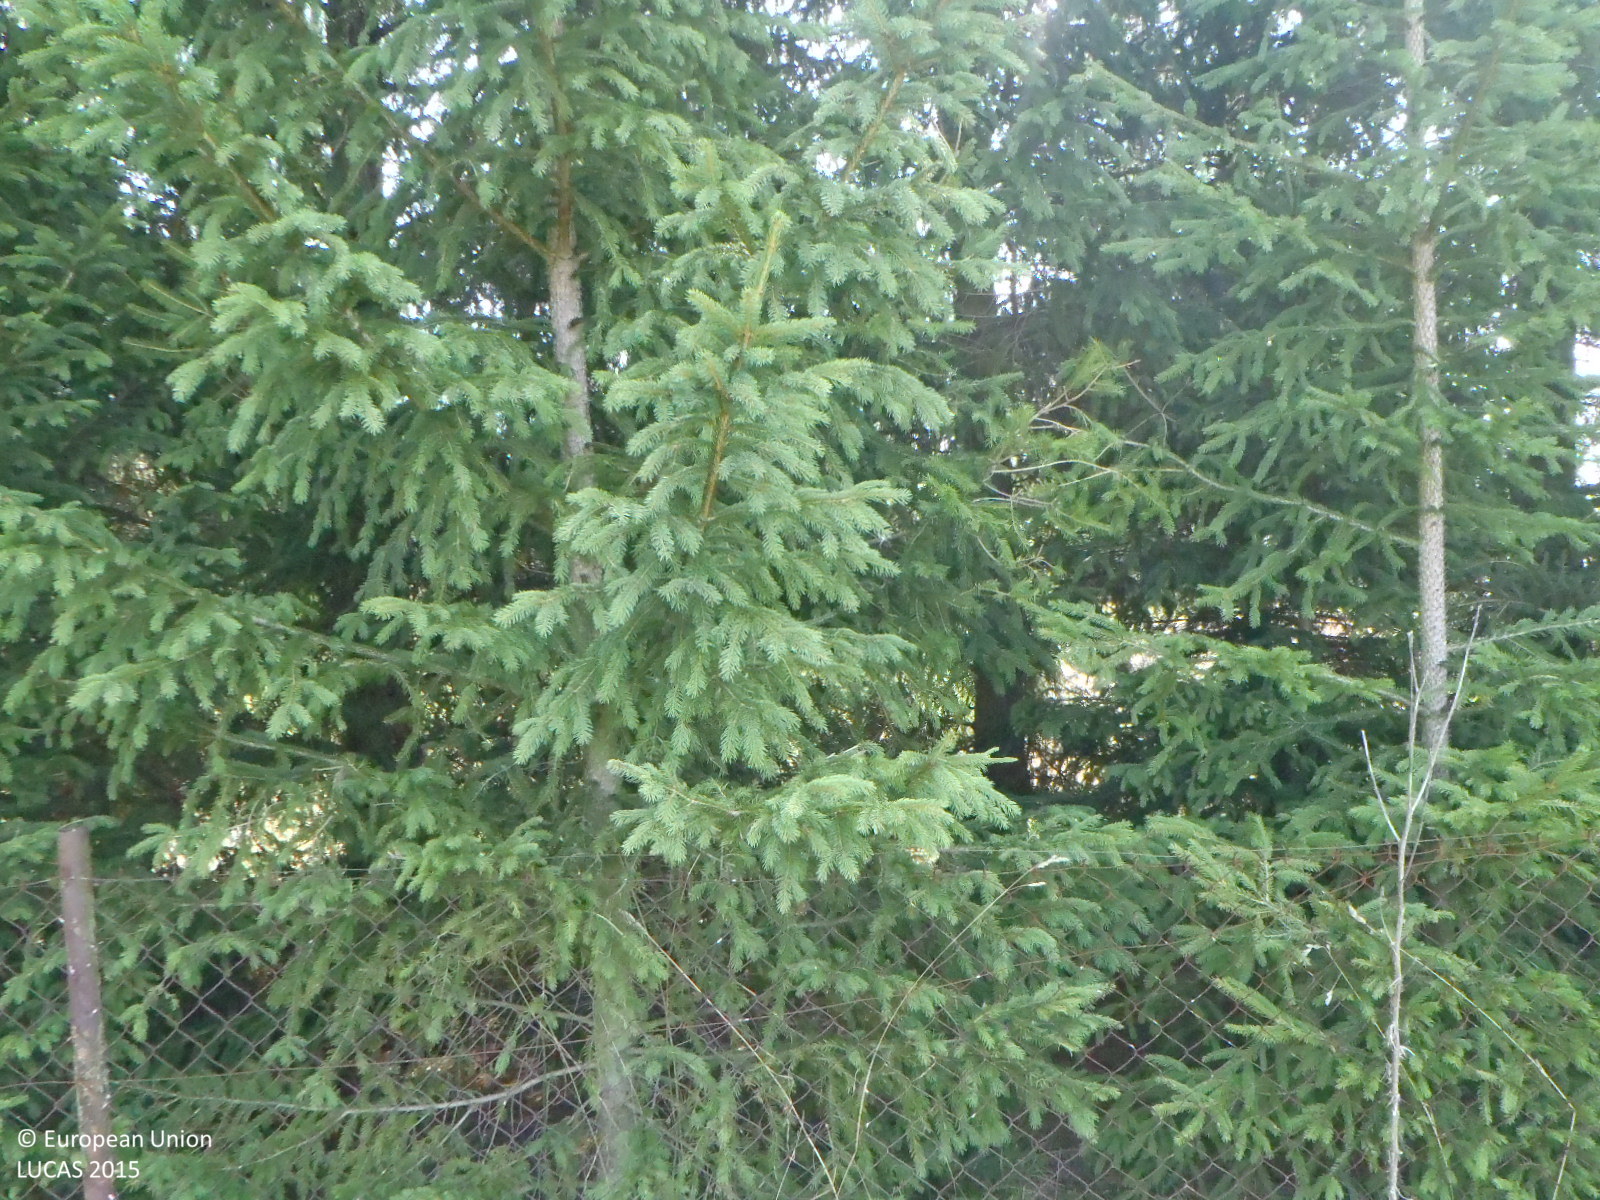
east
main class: Grassland
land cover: Grassland without tree/shrub cover
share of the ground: > 75 %
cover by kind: herbaceous plants 100 %
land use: Agriculture (excluding fallow land and kitchen gardens)
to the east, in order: Grassland without tree/shrub cover; Artificial constructions in urban areas; Grass margins; Broadleaved woodland; Rivers and streams; Broadleaved woodland
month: August
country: CZ
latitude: 50.7238
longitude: 14.5491
